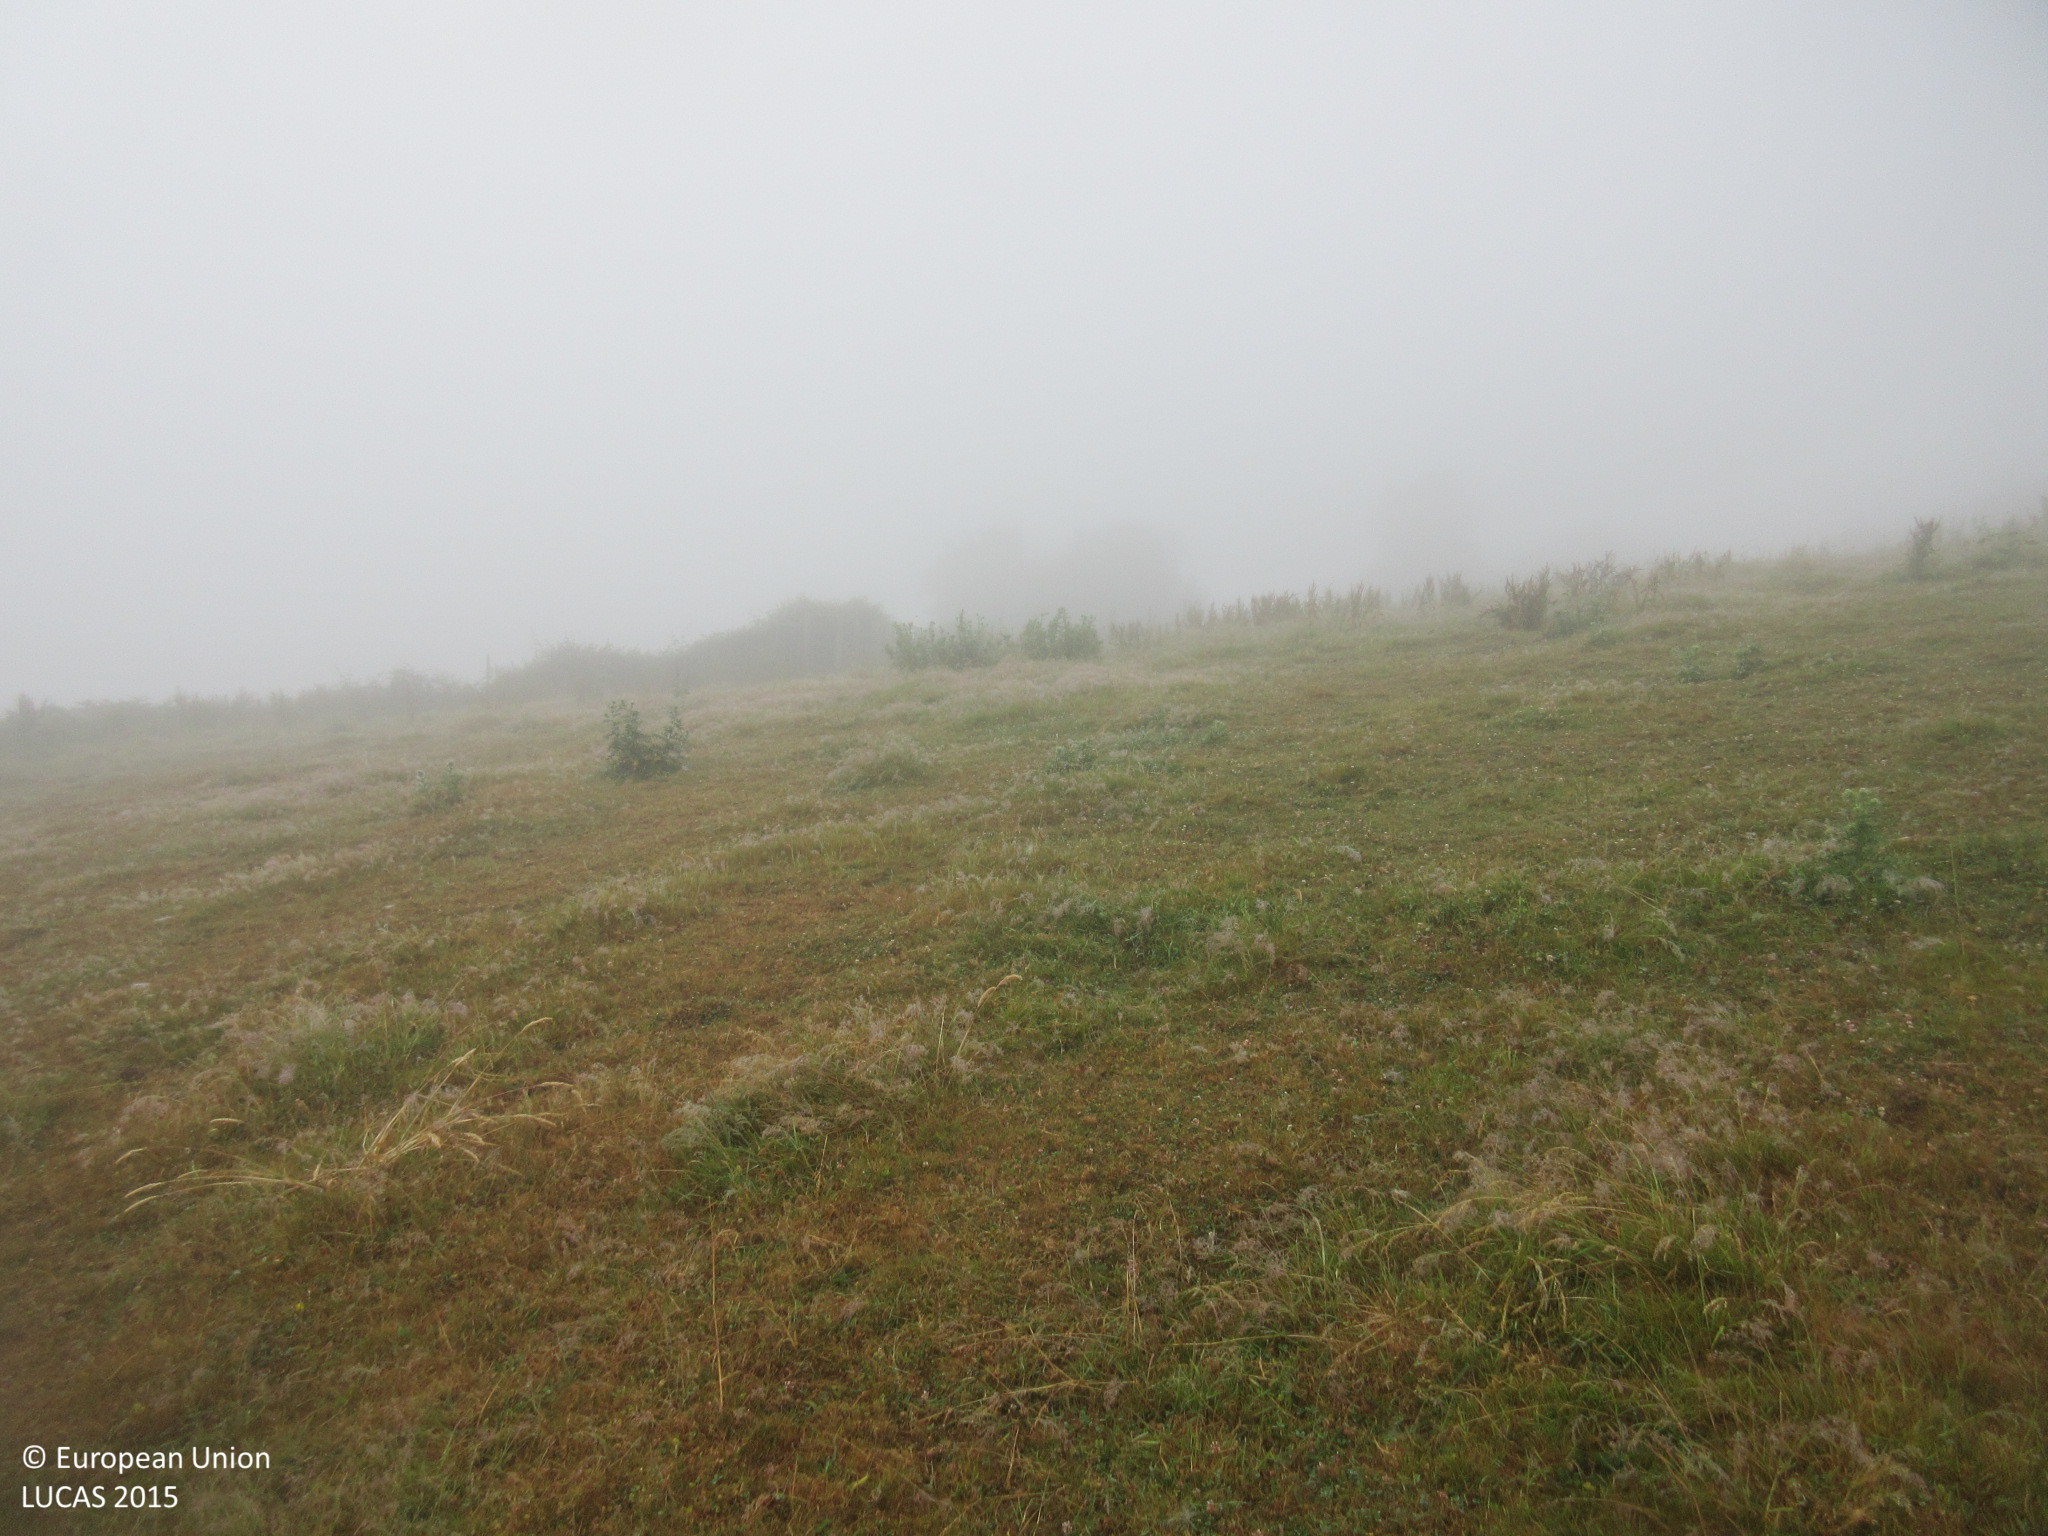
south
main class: Grassland
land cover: Grassland without tree/shrub cover
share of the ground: > 75 %
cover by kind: herbaceous plants 100 %
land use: Agriculture (excluding fallow land and kitchen gardens)
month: June
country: ES
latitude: 43.2399
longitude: -7.0483
